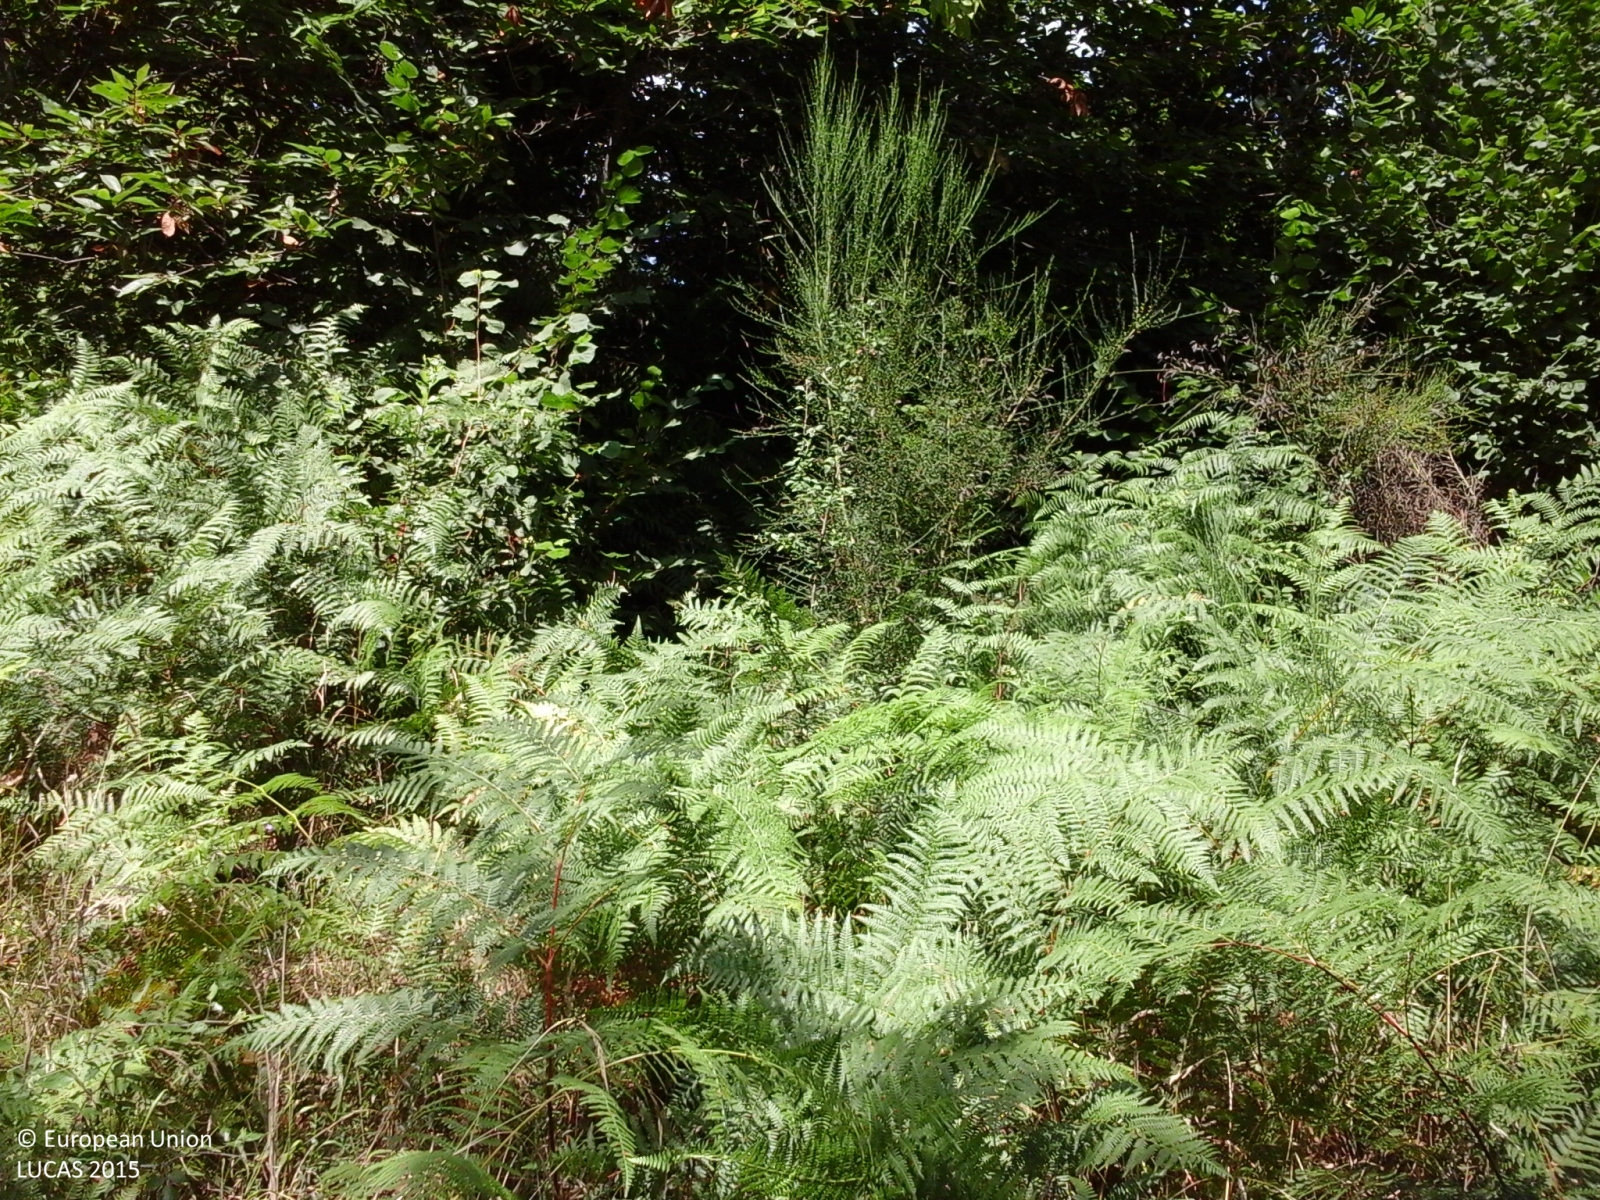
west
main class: Woodland
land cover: Broadleaved woodland
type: thermophilous deciduous forest
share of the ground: > 75 %
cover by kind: broadleaved forest trees 90 %, shrubs 5 %, herbaceous plants 5 %
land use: Semi-natural and natural areas not in use
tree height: > 5 m
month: July
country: IT
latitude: 41.5978
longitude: 12.9758
